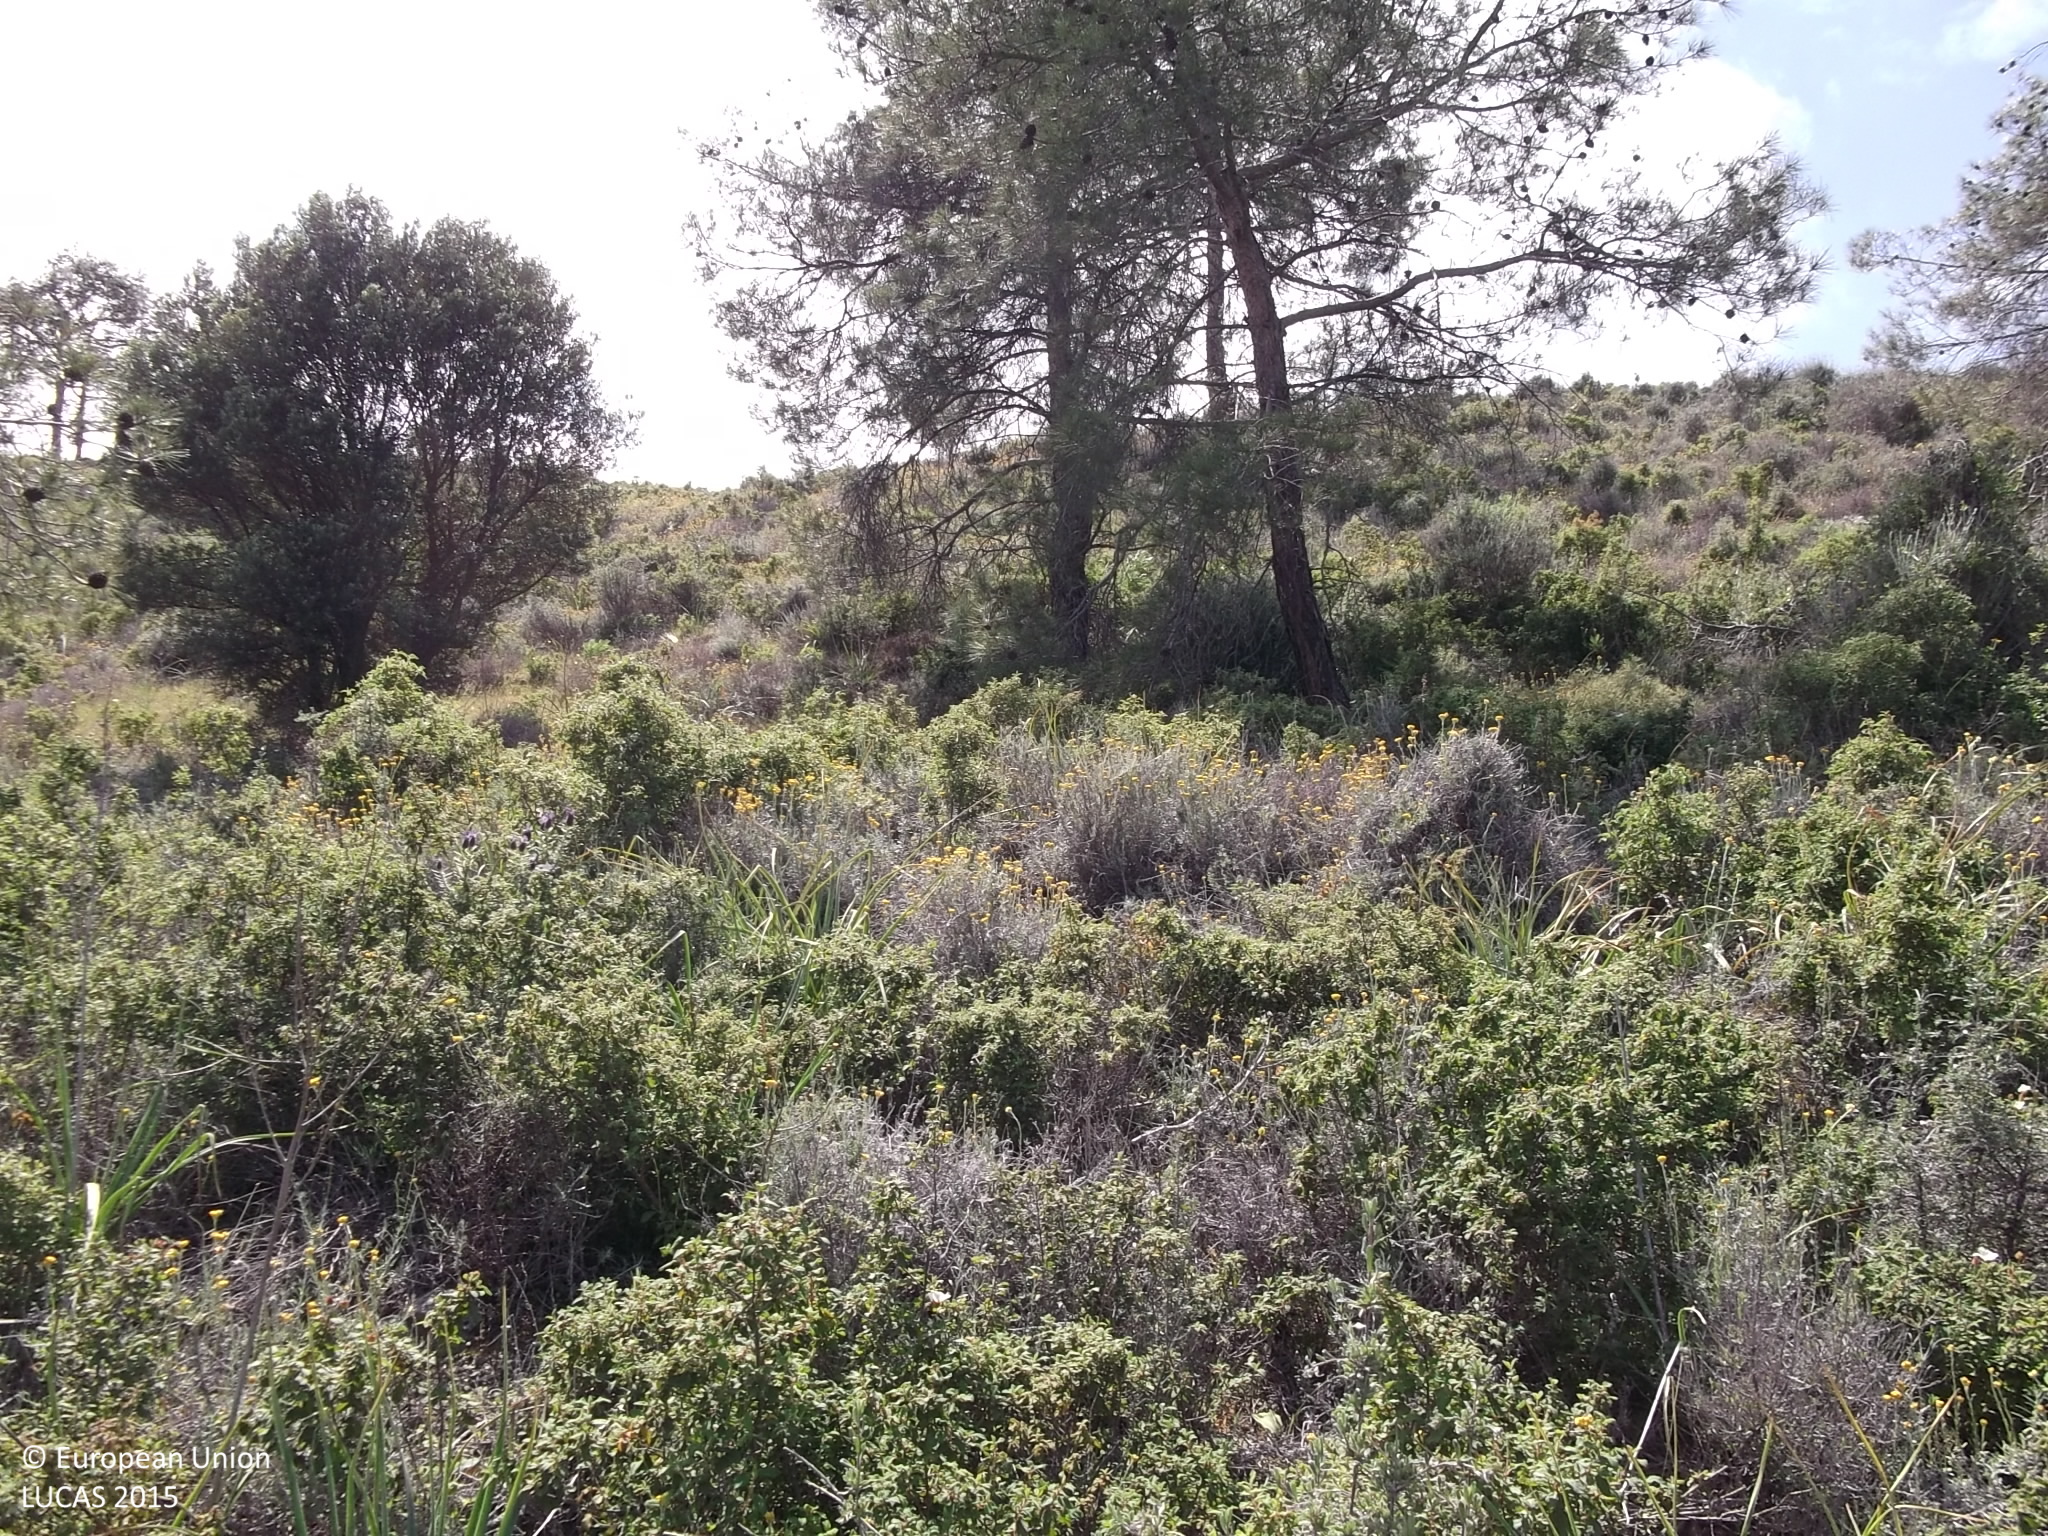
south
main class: Woodland
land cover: Pine dominated coniferous woodland
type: coniferous forest of the mediterranean region
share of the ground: > 75 %
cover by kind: coniferous forest trees 70 %, shrubs 25 %, broadleaved forest trees 5 %
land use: Semi-natural and natural areas not in use
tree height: > 5 m
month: April
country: CY
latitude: 34.8698
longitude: 33.4331
